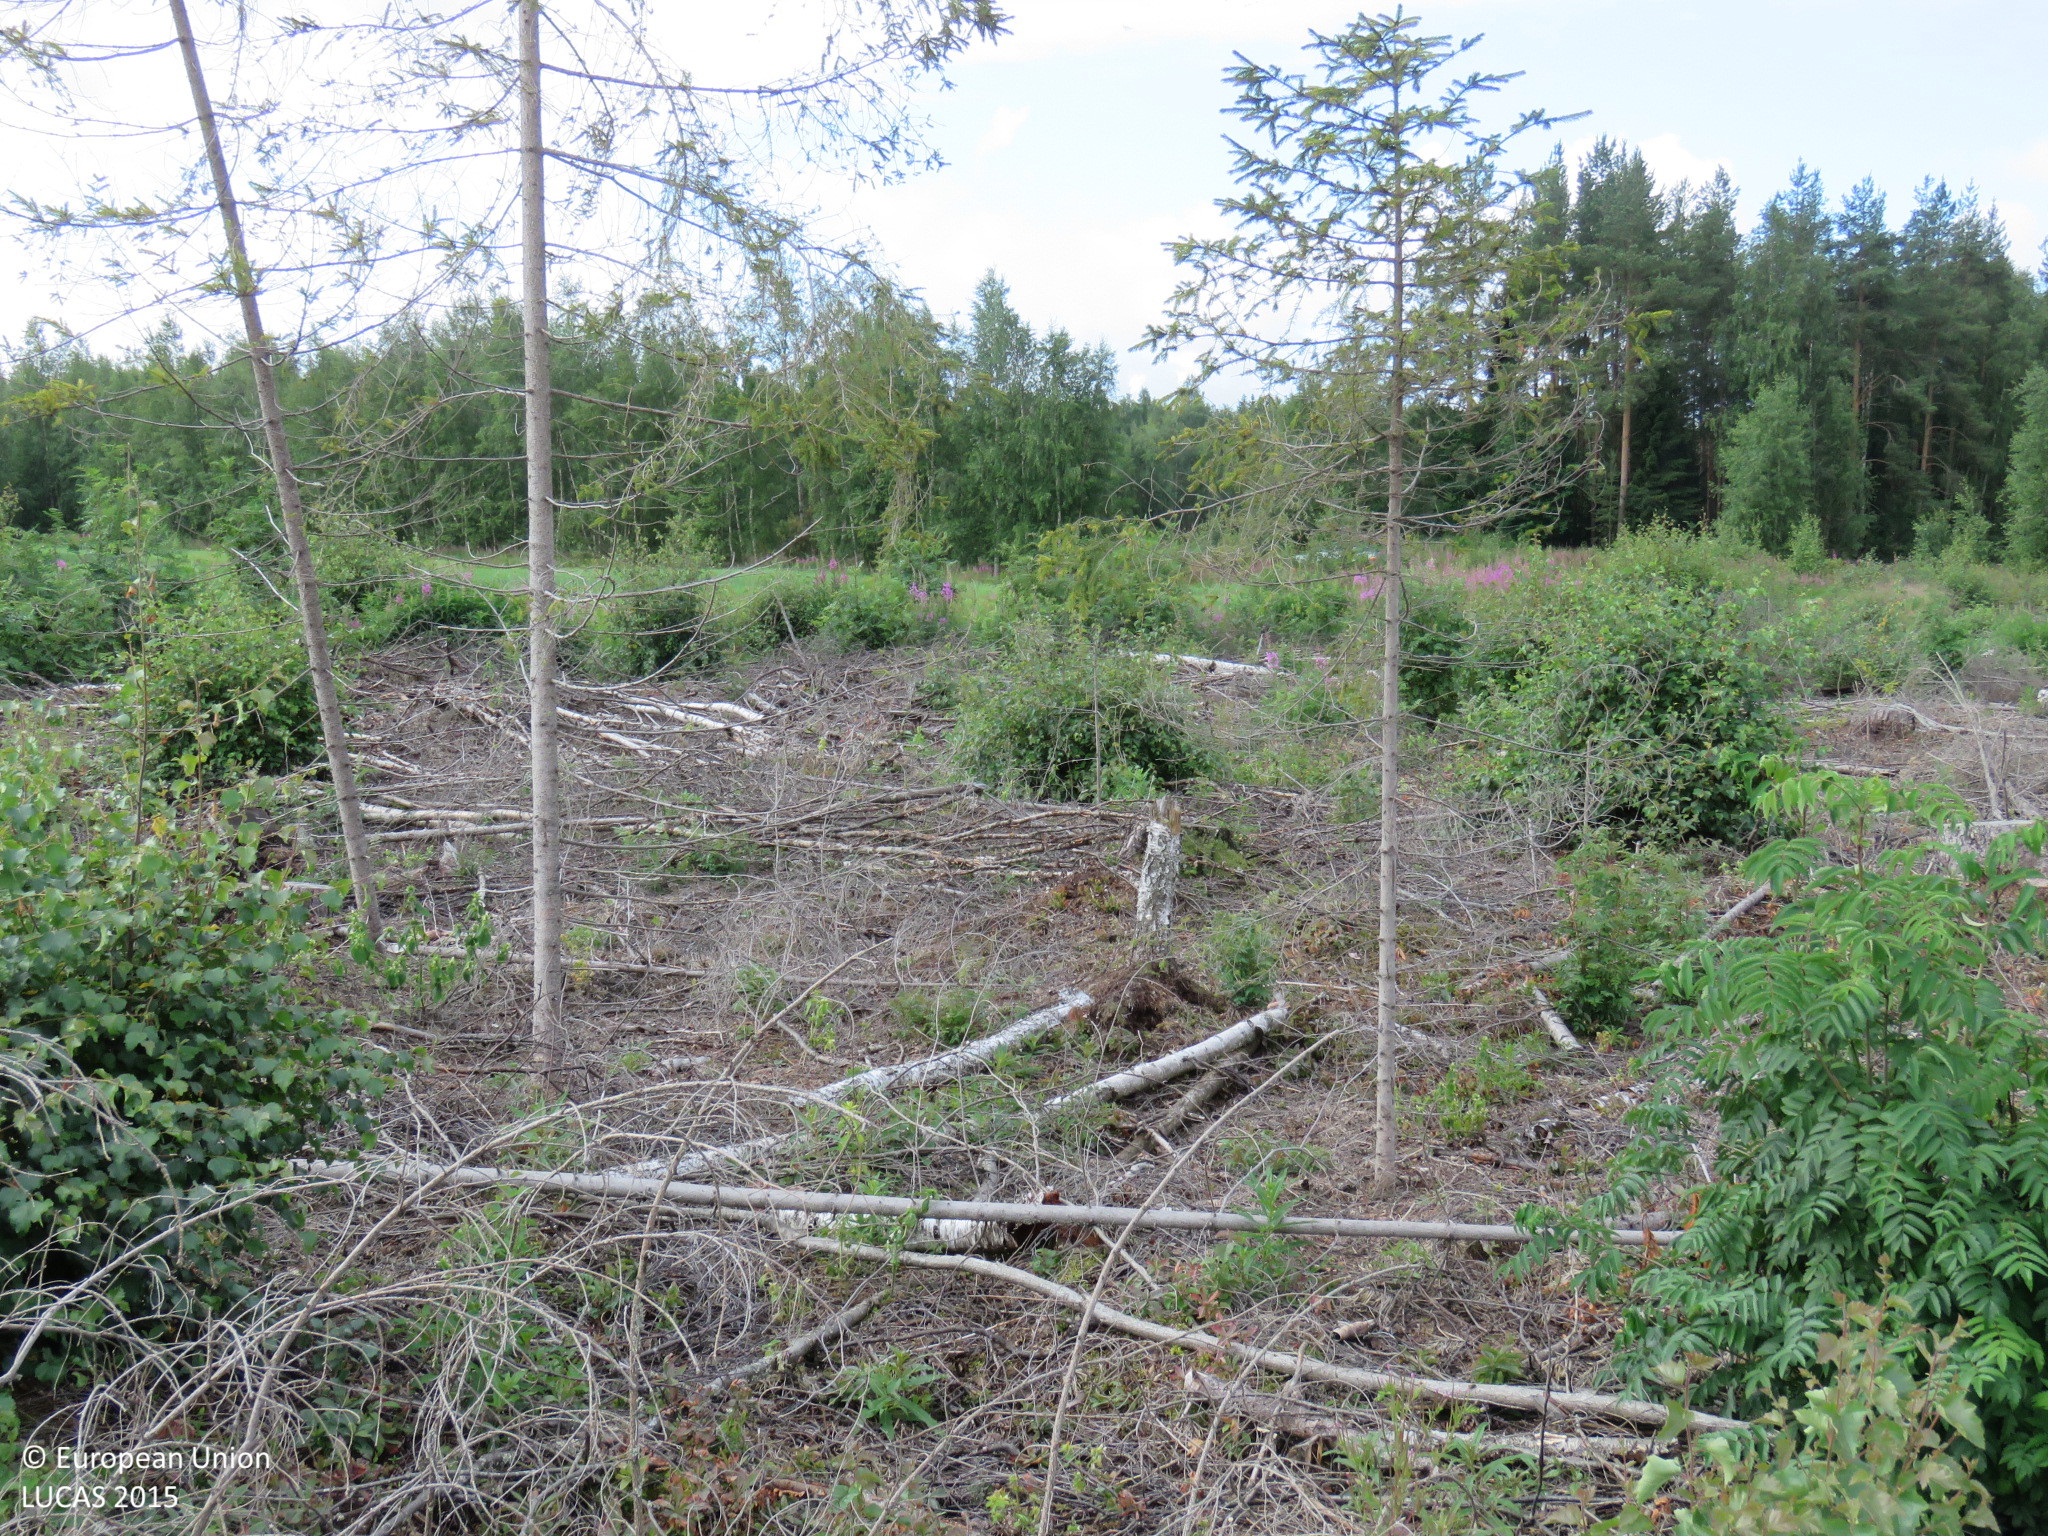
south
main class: Woodland
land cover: Broadleaved woodland
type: boreal forest
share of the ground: 10 - 25 %
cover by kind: broadleaved forest trees 15 %, herbaceous plants 10 %, unconsolidated bare surface 10 %, coniferous forest trees 5 %, shrubs 5 %
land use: Forestry
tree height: < 5 m
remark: Clear cut
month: July
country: FI
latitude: 64.8812
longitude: 25.5625
